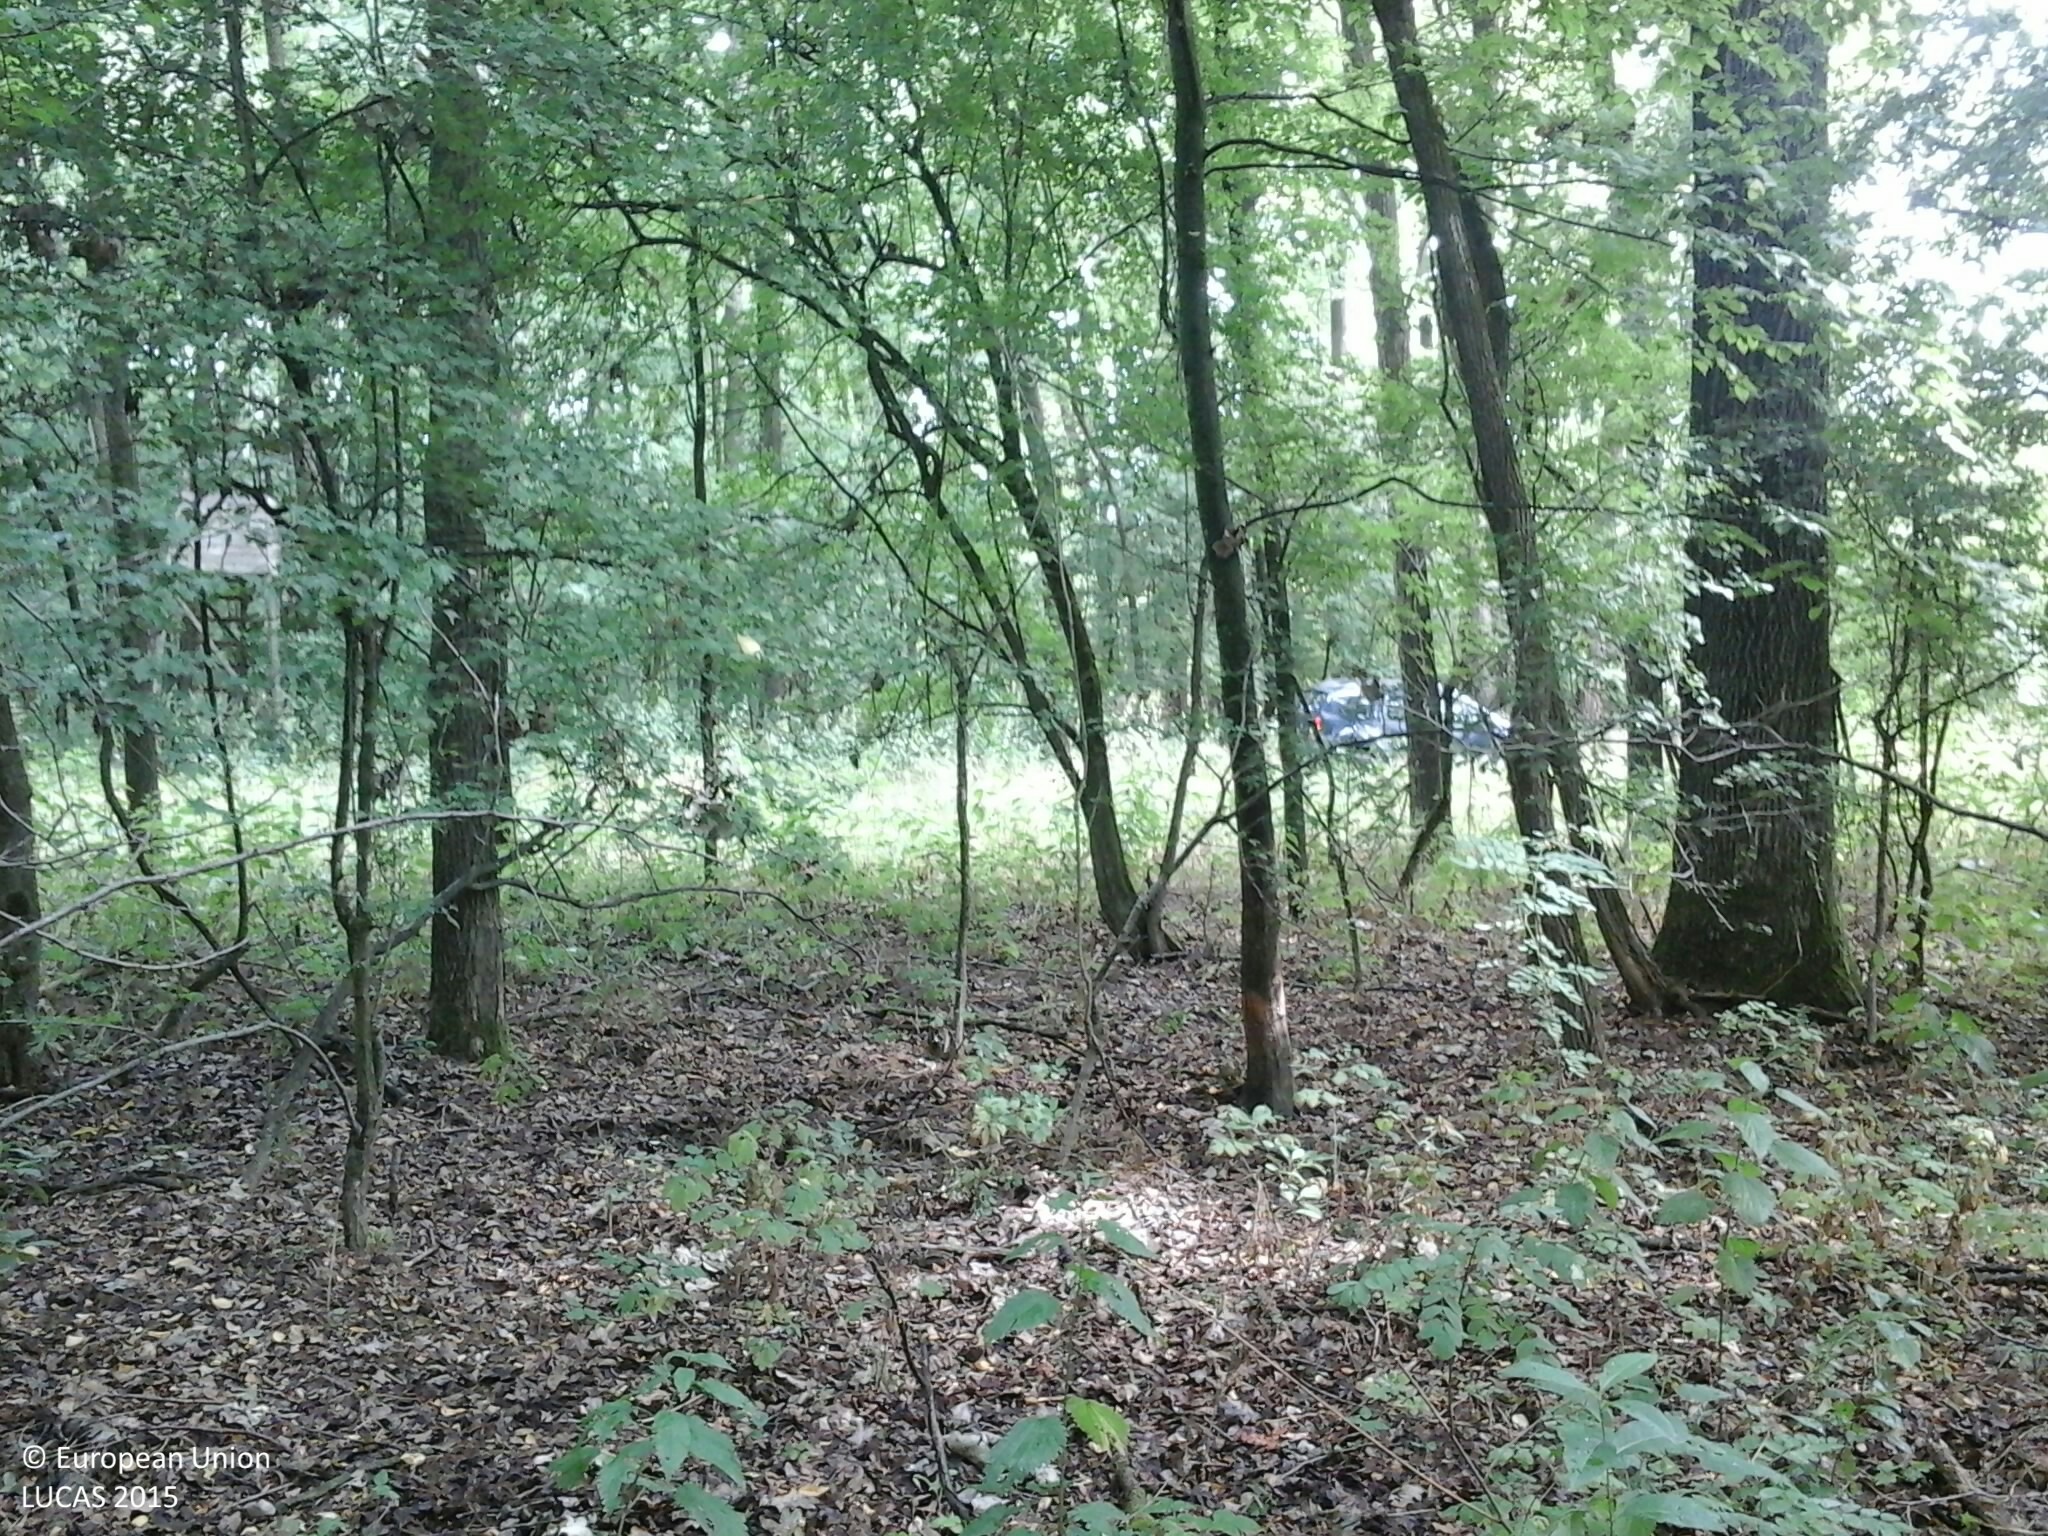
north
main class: Woodland
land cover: Broadleaved woodland
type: mesophytic deciduous forest
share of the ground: > 75 %
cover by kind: broadleaved forest trees 95 %, herbaceous plants 5 %
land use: Forestry
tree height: > 5 m
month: July
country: HU
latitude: 47.9199
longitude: 22.0832
